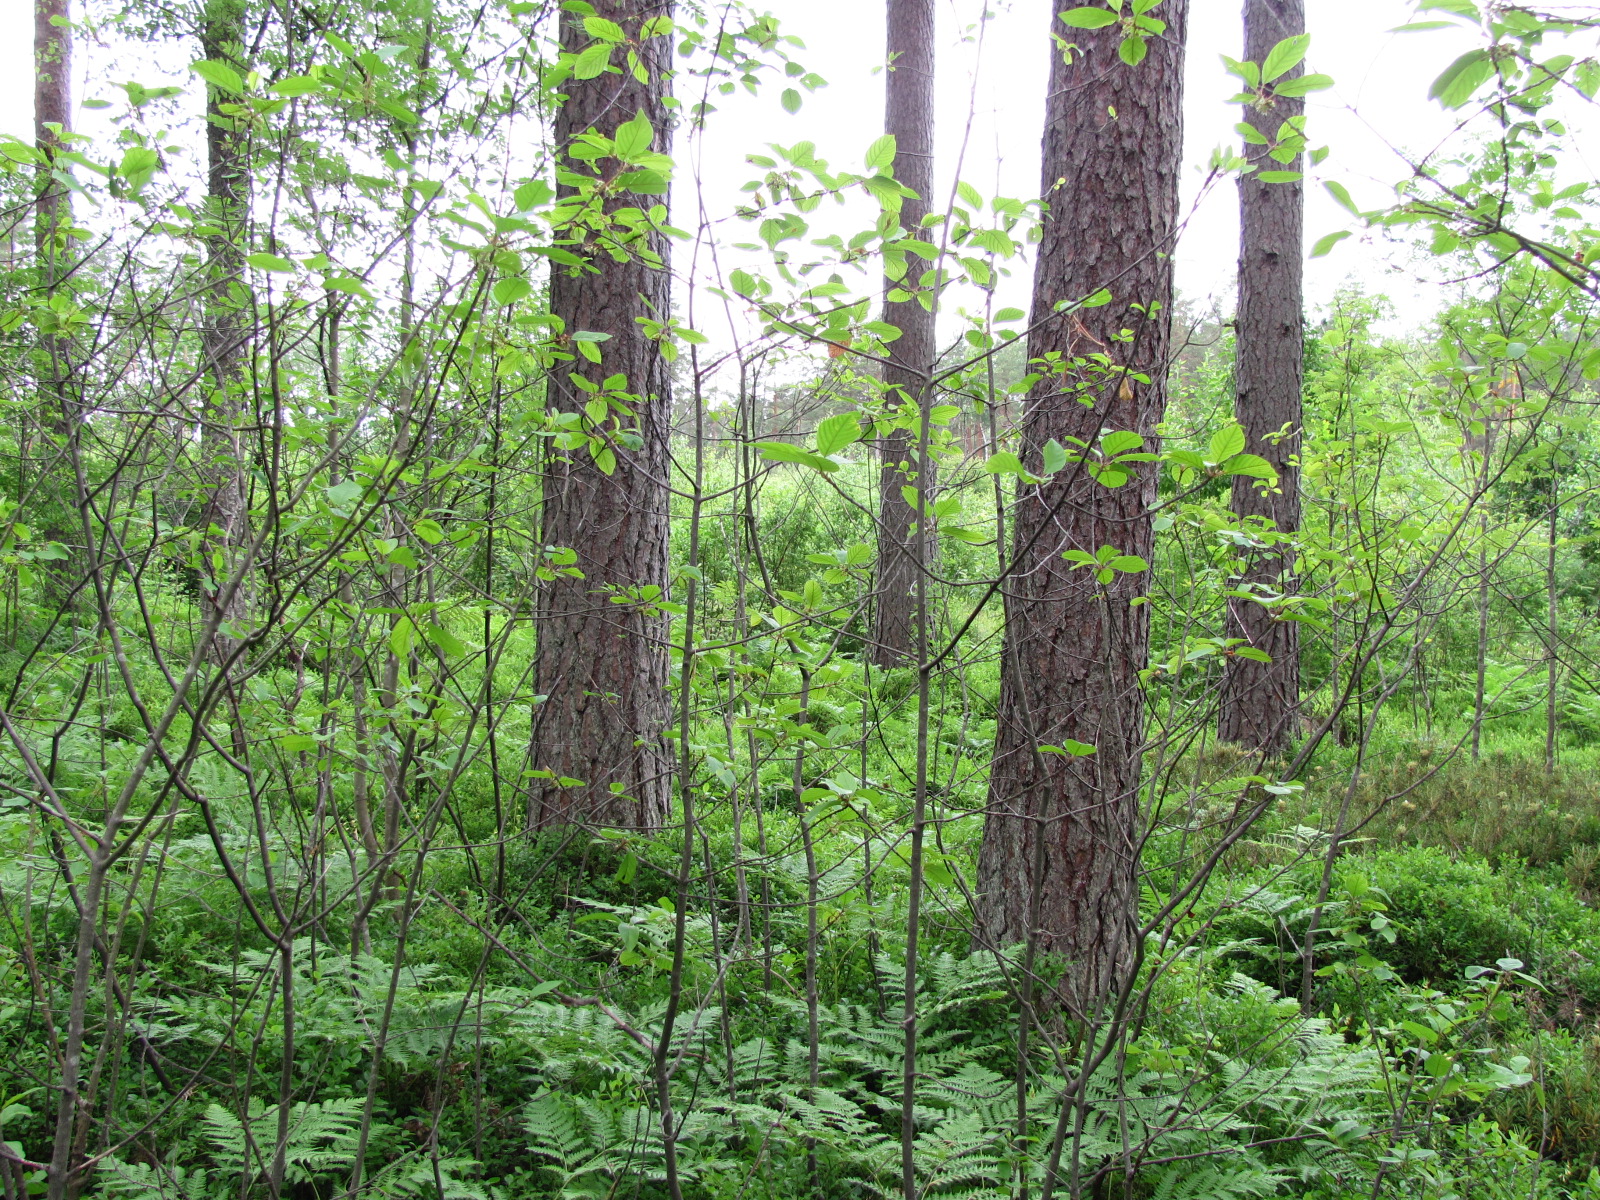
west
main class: Woodland
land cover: Pine dominated mixed woodland
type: hemiboreal forest and nemoral coniferous forest and mixed broadleaved-coniferous forest
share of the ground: > 75 %
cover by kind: coniferous forest trees 60 %, broadleaved forest trees 25 %, herbaceous plants 15 %
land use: Forestry
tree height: > 5 m
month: June
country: LV
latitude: 56.9078
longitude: 23.8920
